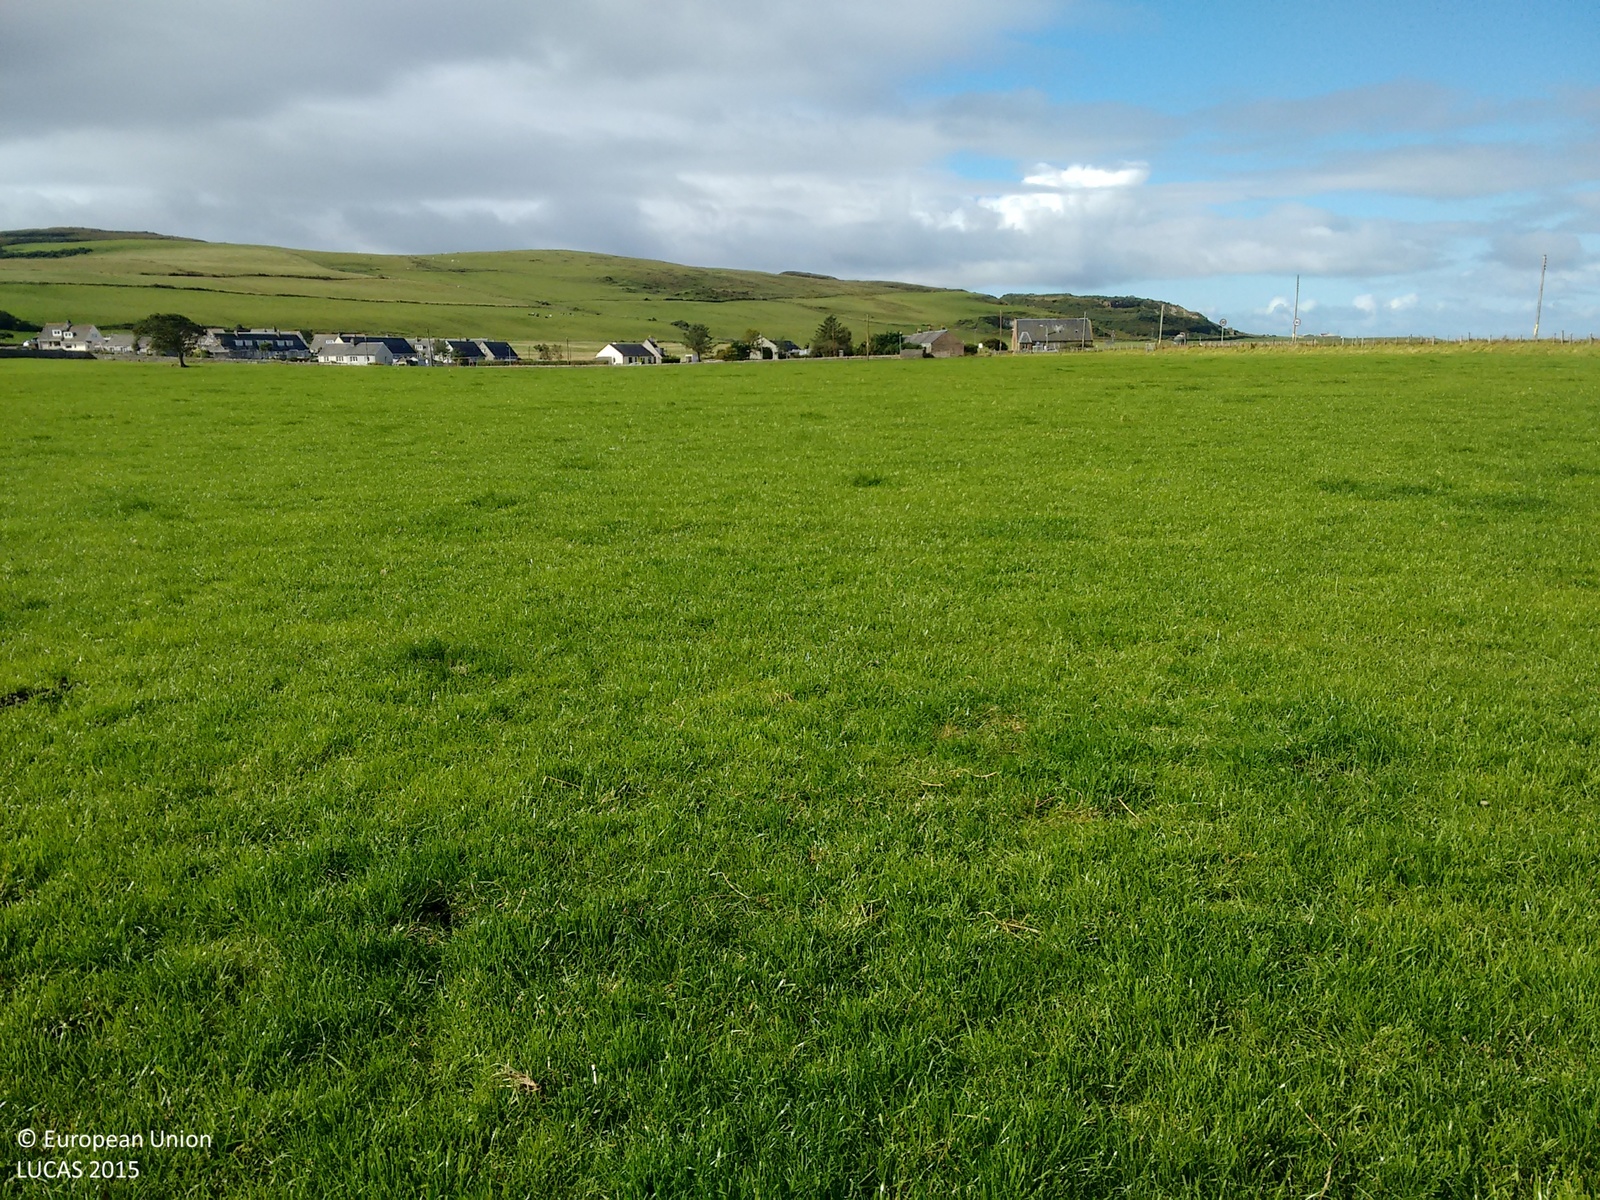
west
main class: Grassland
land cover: Grassland without tree/shrub cover
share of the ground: > 75 %
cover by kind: herbaceous plants 100 %
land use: Agriculture (excluding fallow land and kitchen gardens)
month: September
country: GB
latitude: 55.4155
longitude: -5.6896
